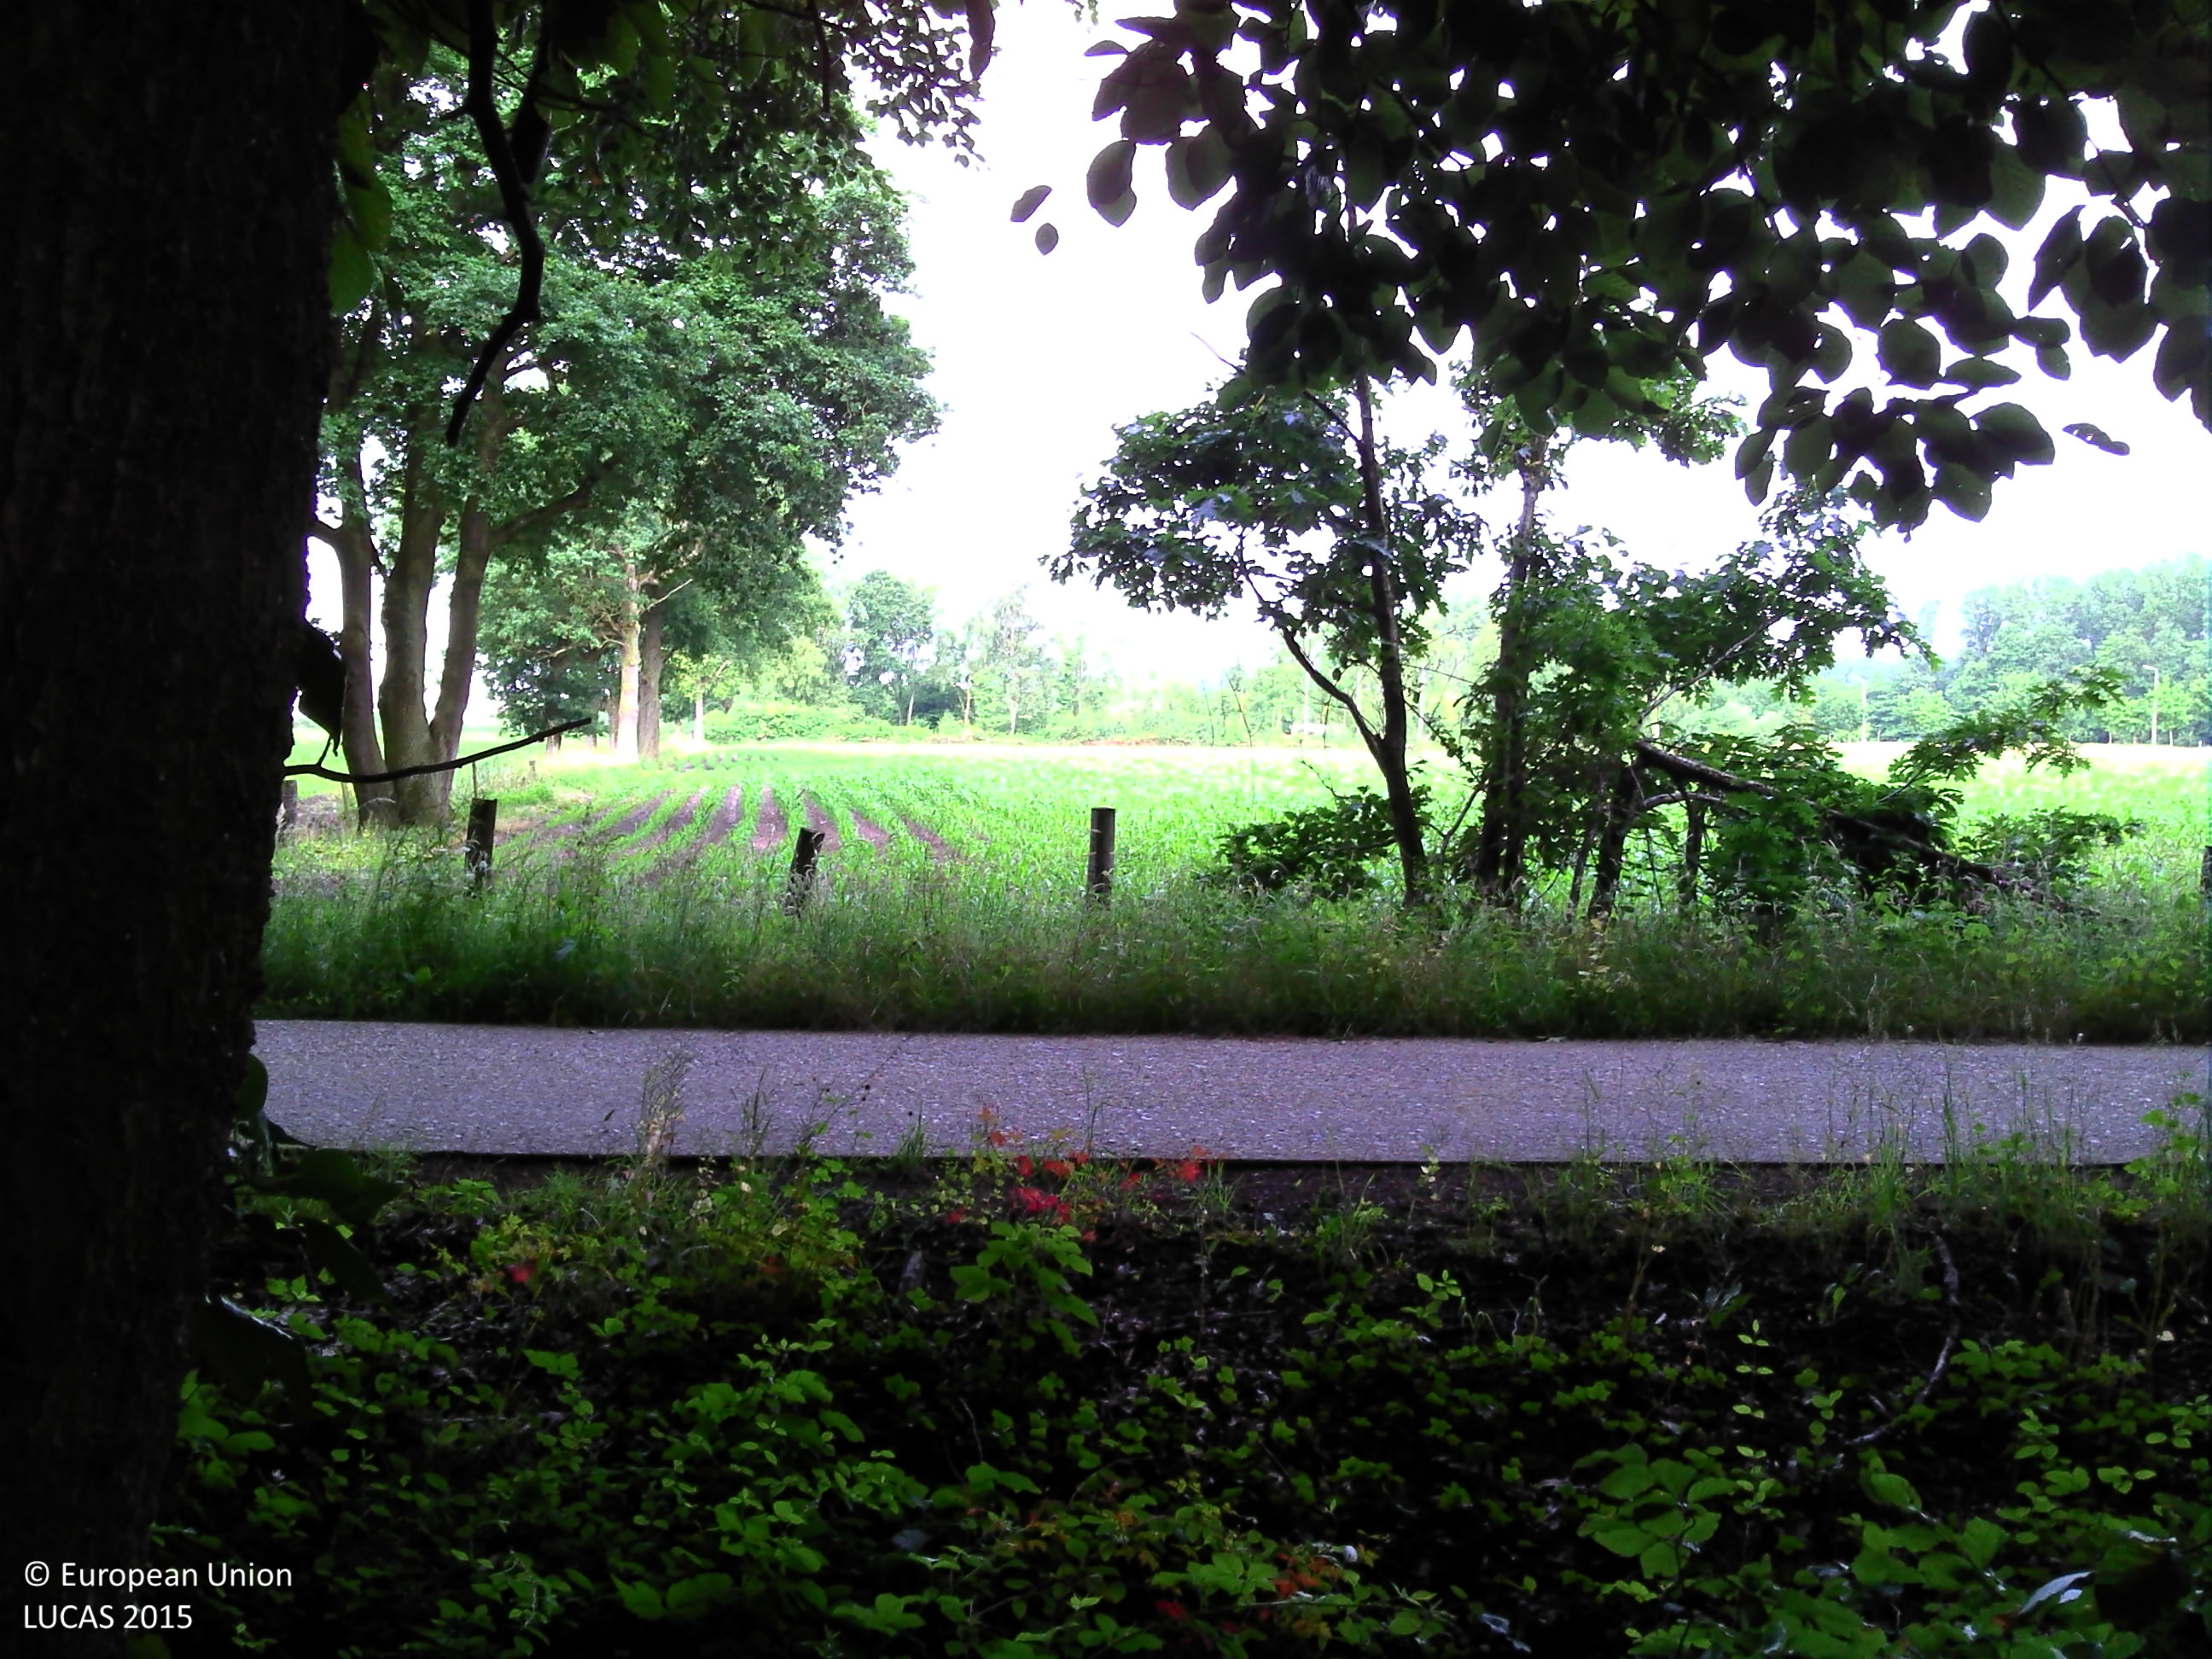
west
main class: Woodland
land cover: Broadleaved woodland
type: acidophilous oak and oak-birch forest
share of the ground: > 75 %
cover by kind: broadleaved forest trees 95 %, herbaceous plants 5 %
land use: Forestry
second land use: Amenities, museums, leisure
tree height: > 5 m
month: June
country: BE
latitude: 50.8897
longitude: 5.5486
